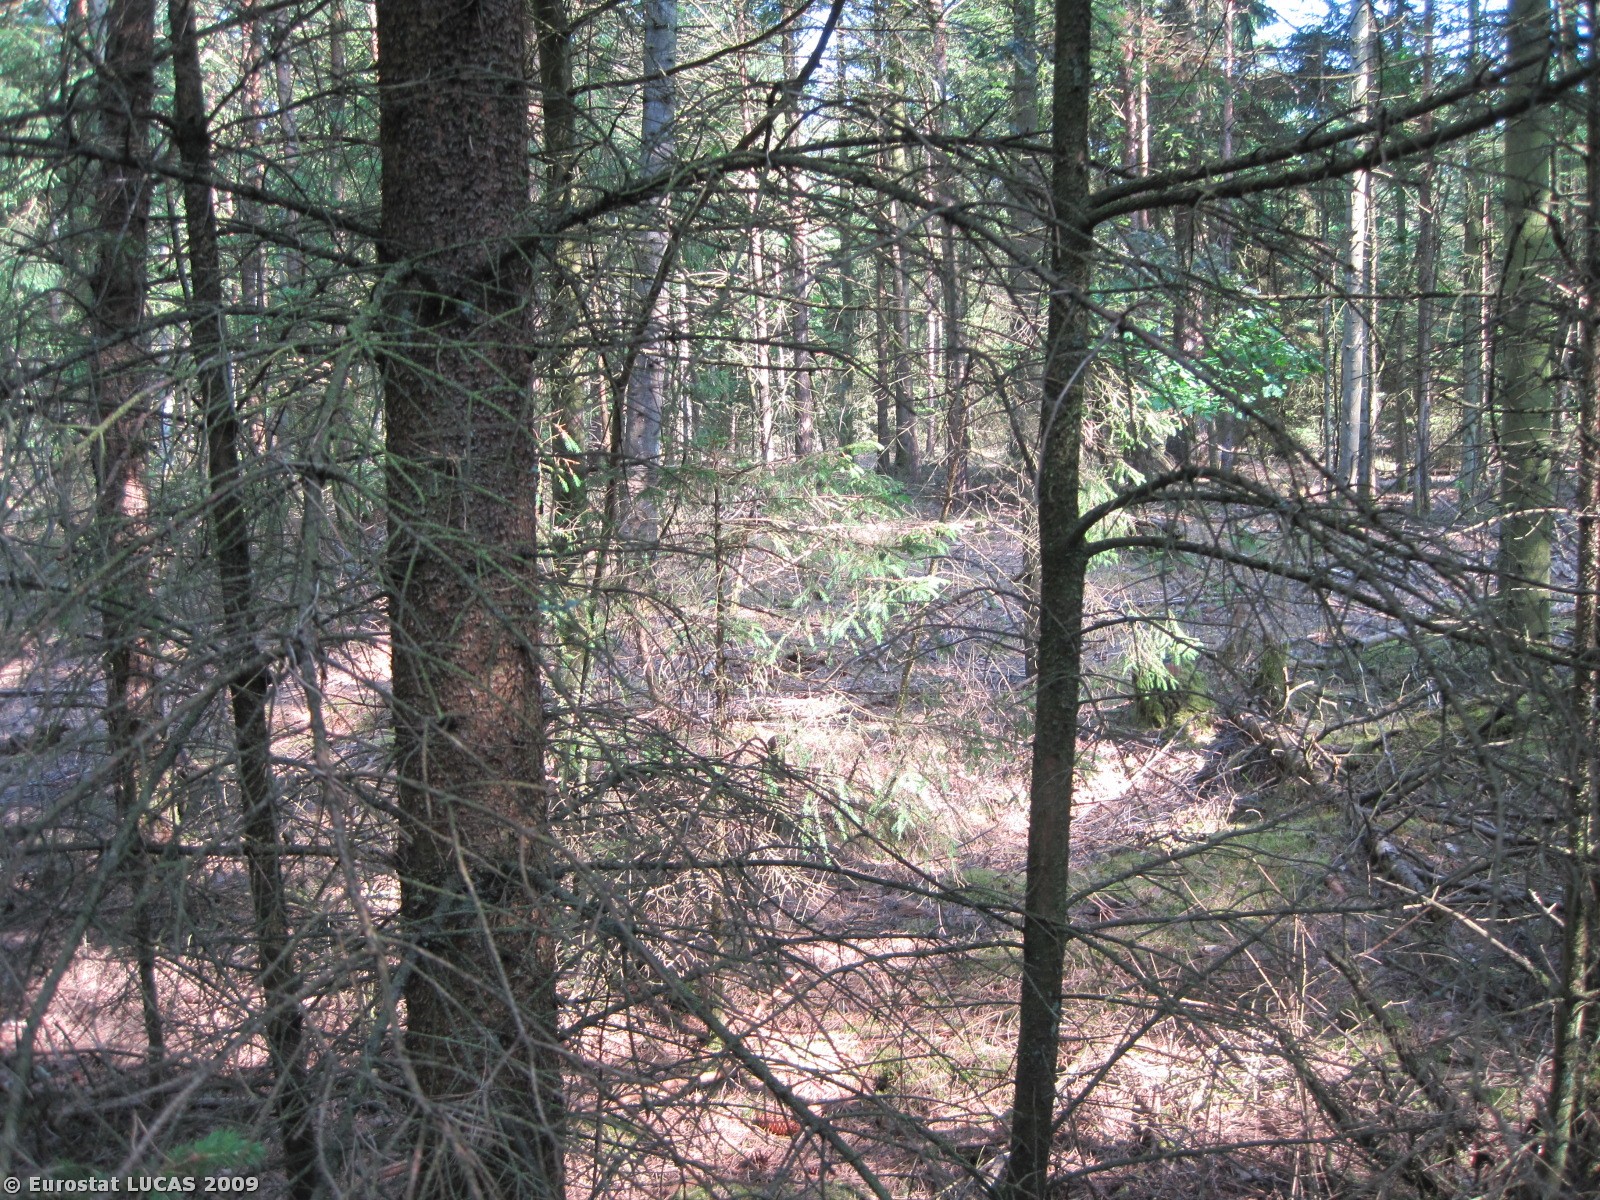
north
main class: Woodland
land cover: Coniferous woodland
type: plantations and self-sown exotic forest
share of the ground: > 75 %
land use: Forestry
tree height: > 5 m
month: July
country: DK
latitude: 56.5065
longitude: 8.8803
